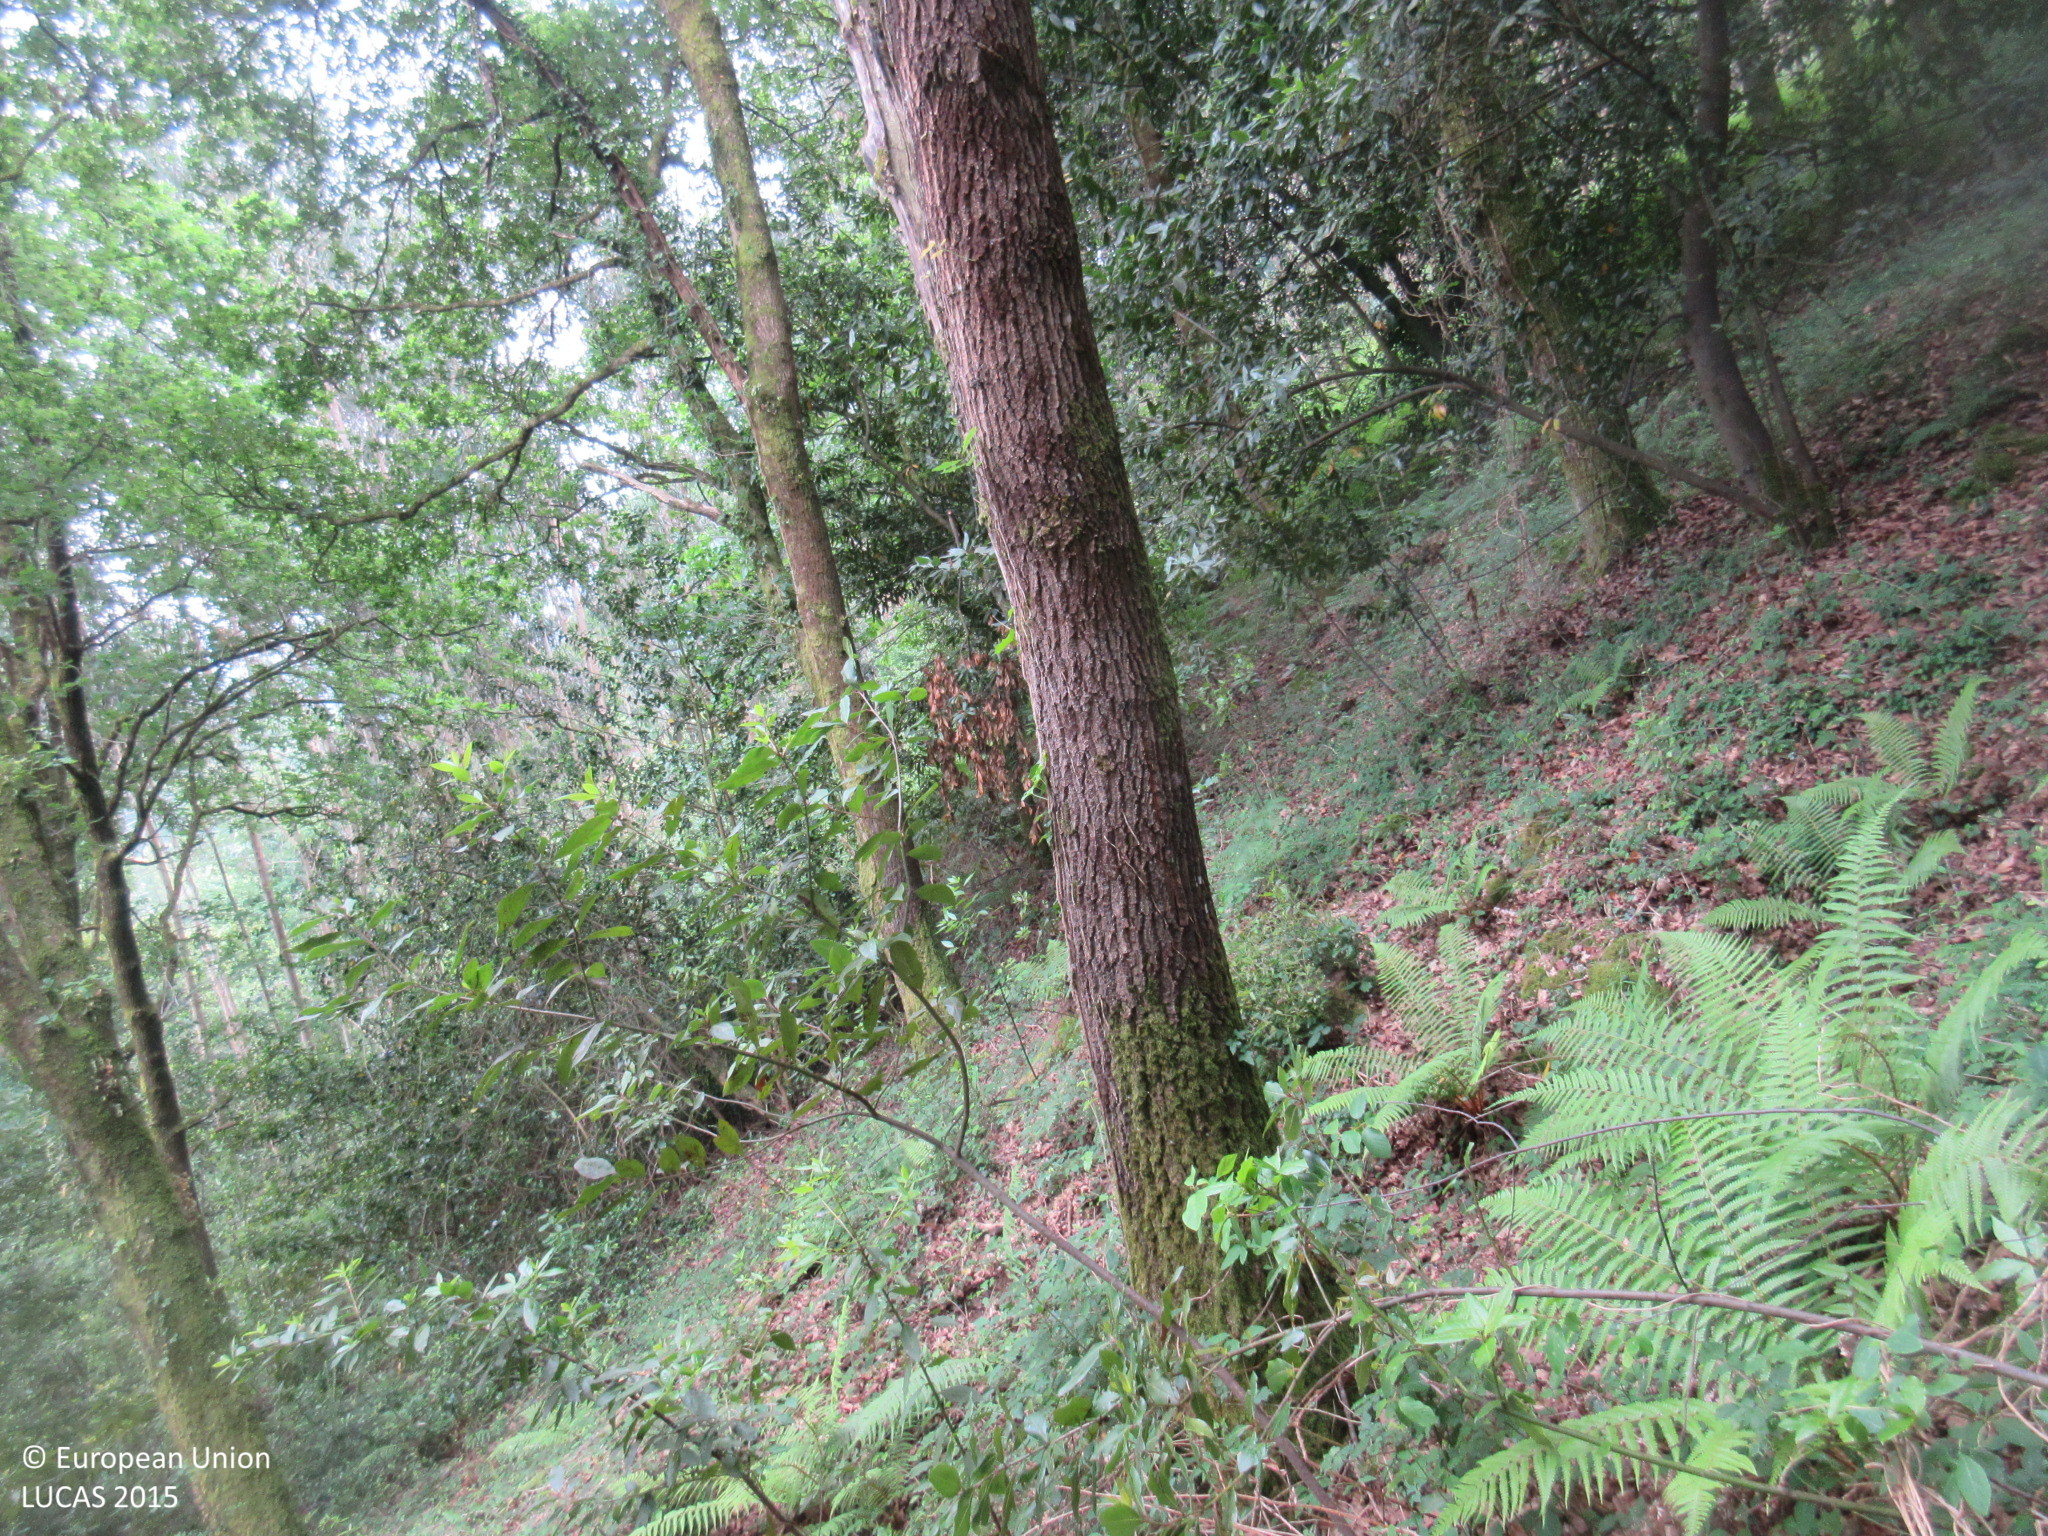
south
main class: Woodland
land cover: Broadleaved woodland
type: thermophilous deciduous forest
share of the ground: > 75 %
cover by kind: broadleaved forest trees 95 %, shrubs 5 %
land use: Forestry
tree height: > 5 m
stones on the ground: < 10 %
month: June
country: ES
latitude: 43.3456
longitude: -3.4267
